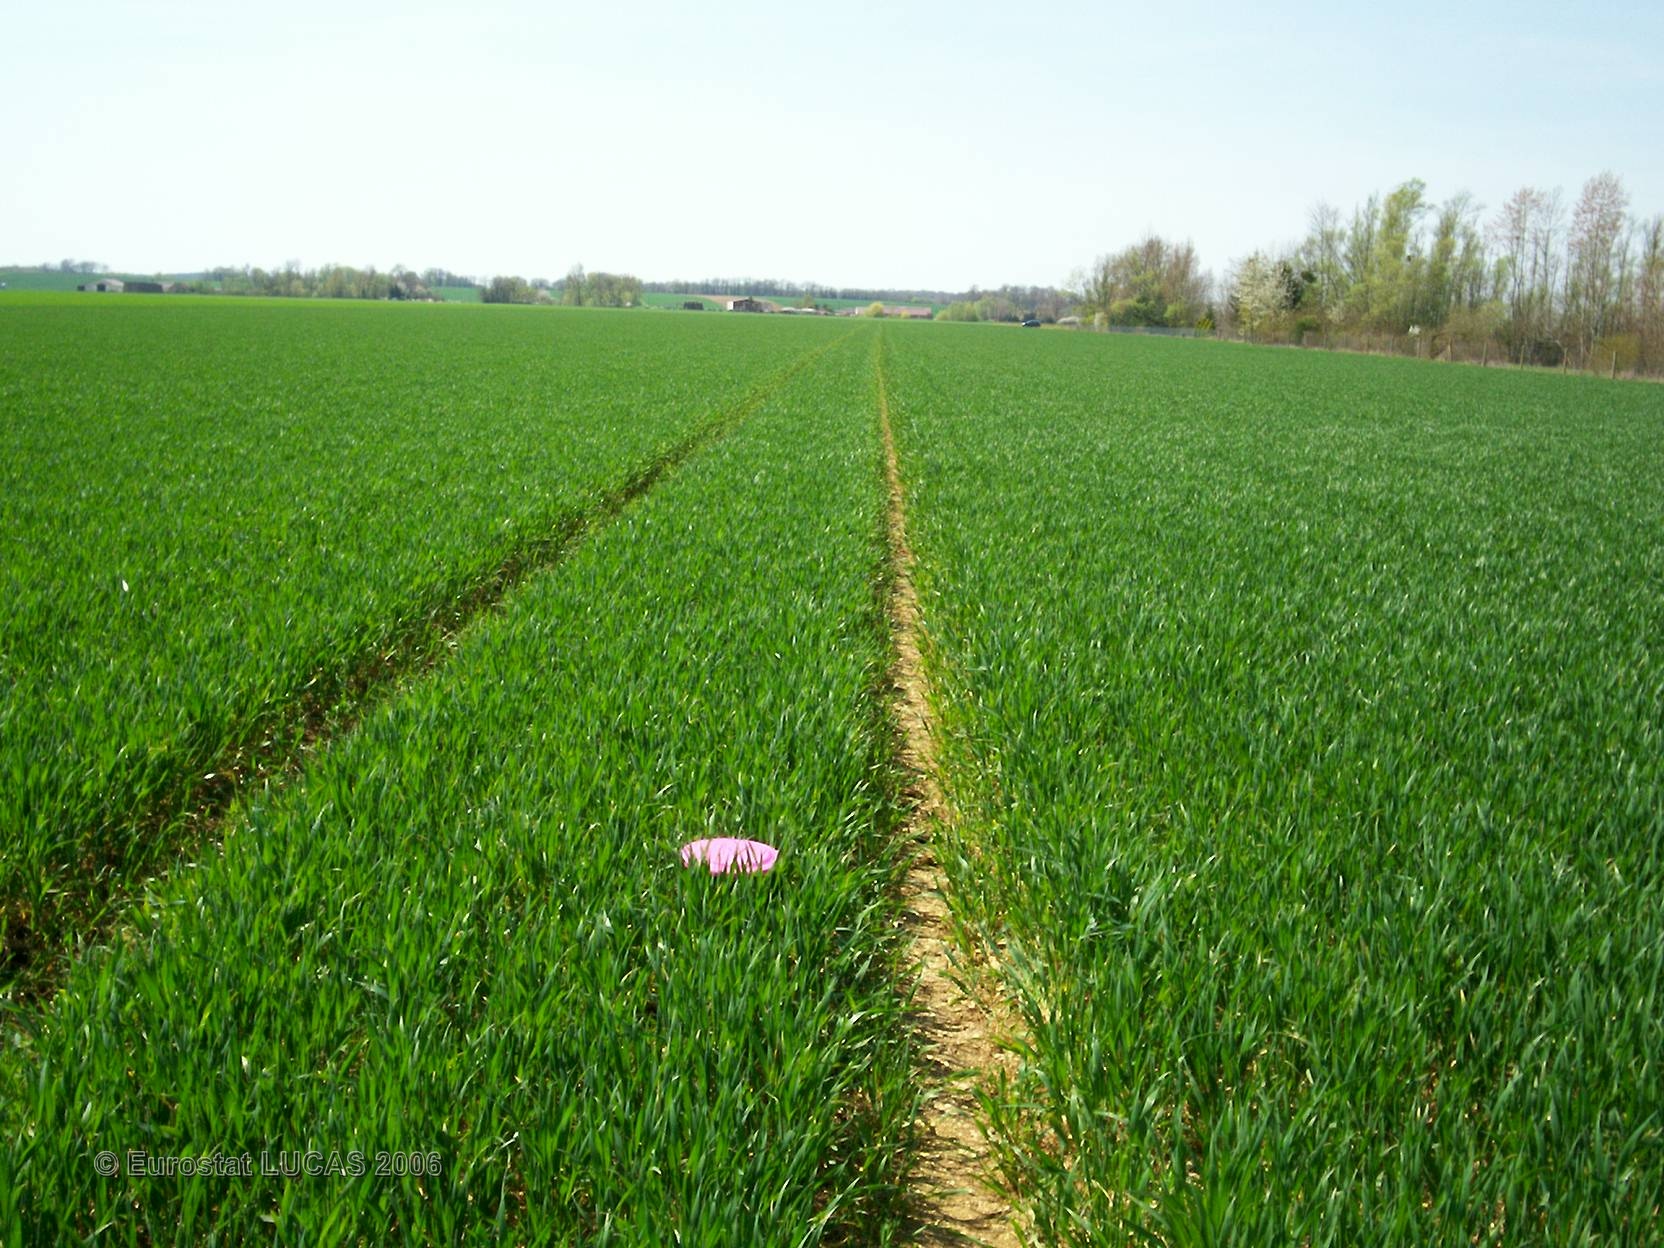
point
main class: Cropland
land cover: Common wheat
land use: Agriculture (excluding fallow land and kitchen gardens)
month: April
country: FR
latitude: 48.4301
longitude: 4.5238
